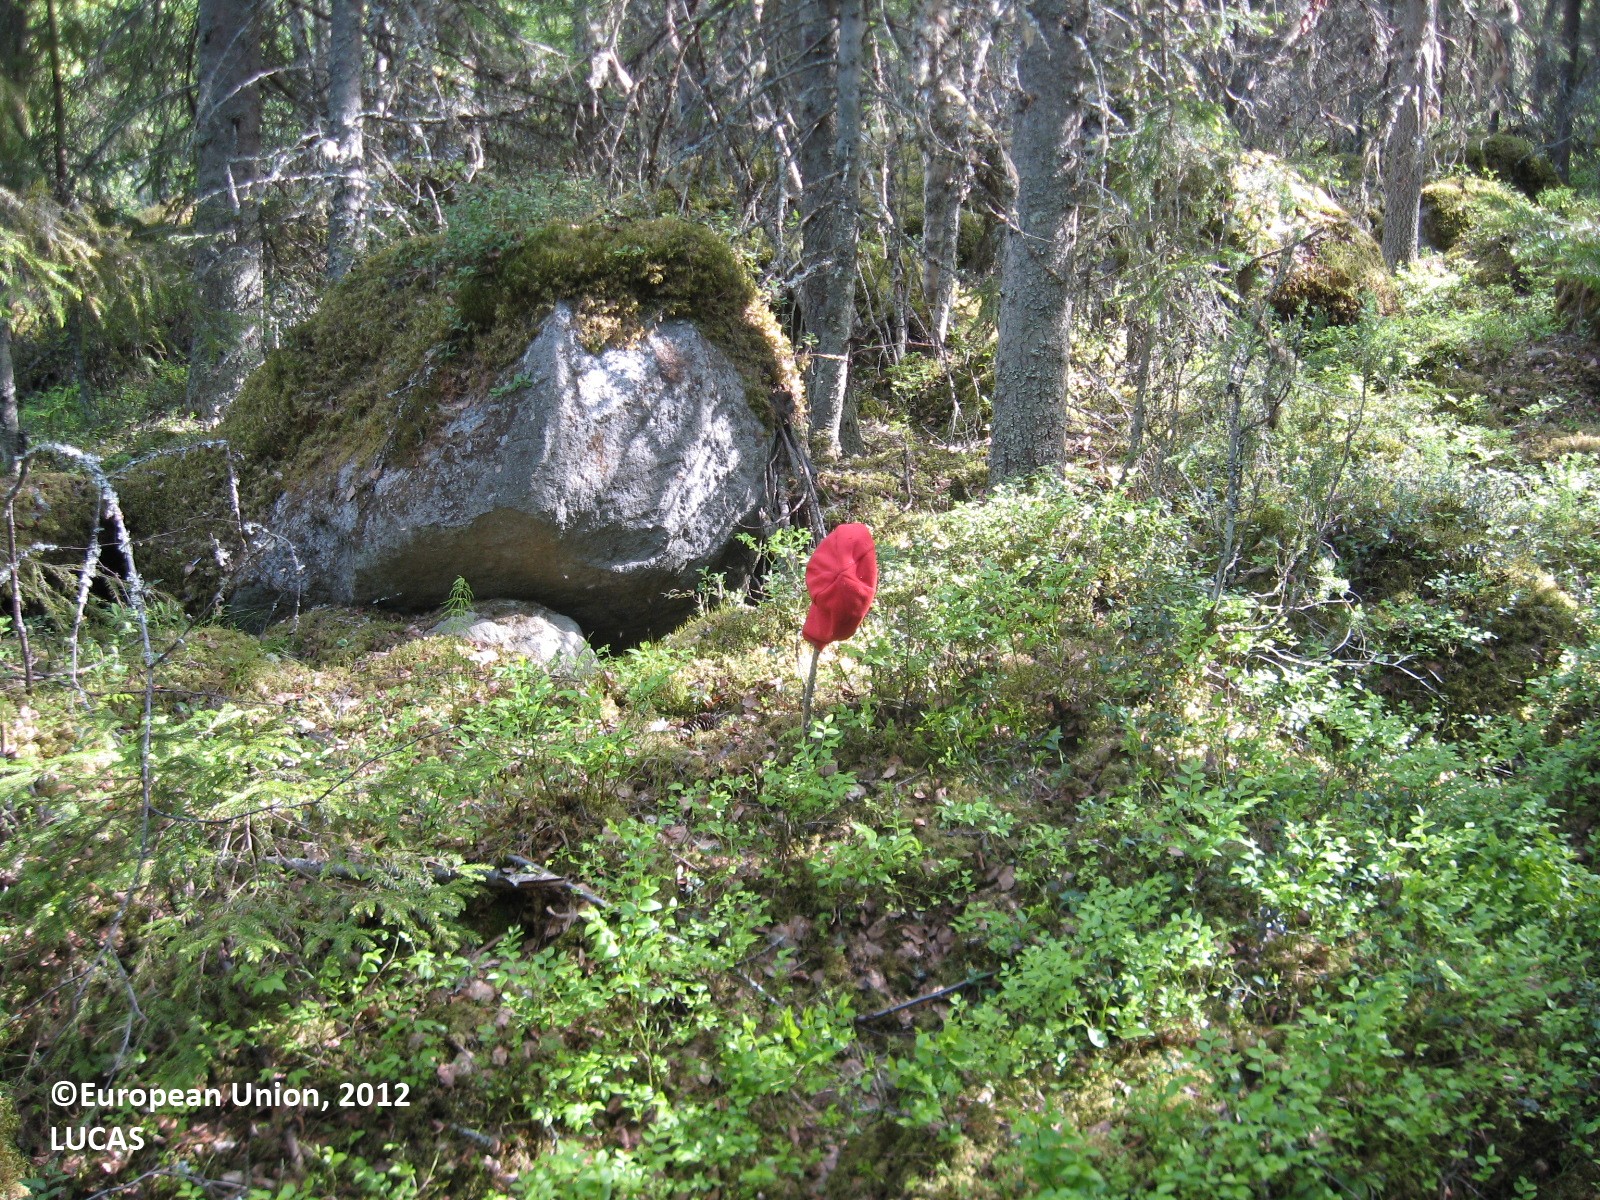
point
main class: Woodland
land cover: Spruce dominated mixed woodland
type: boreal forest
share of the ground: > 75 %
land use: Forestry
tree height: > 5 m
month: June
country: FI
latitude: 63.2157
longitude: 21.9171
